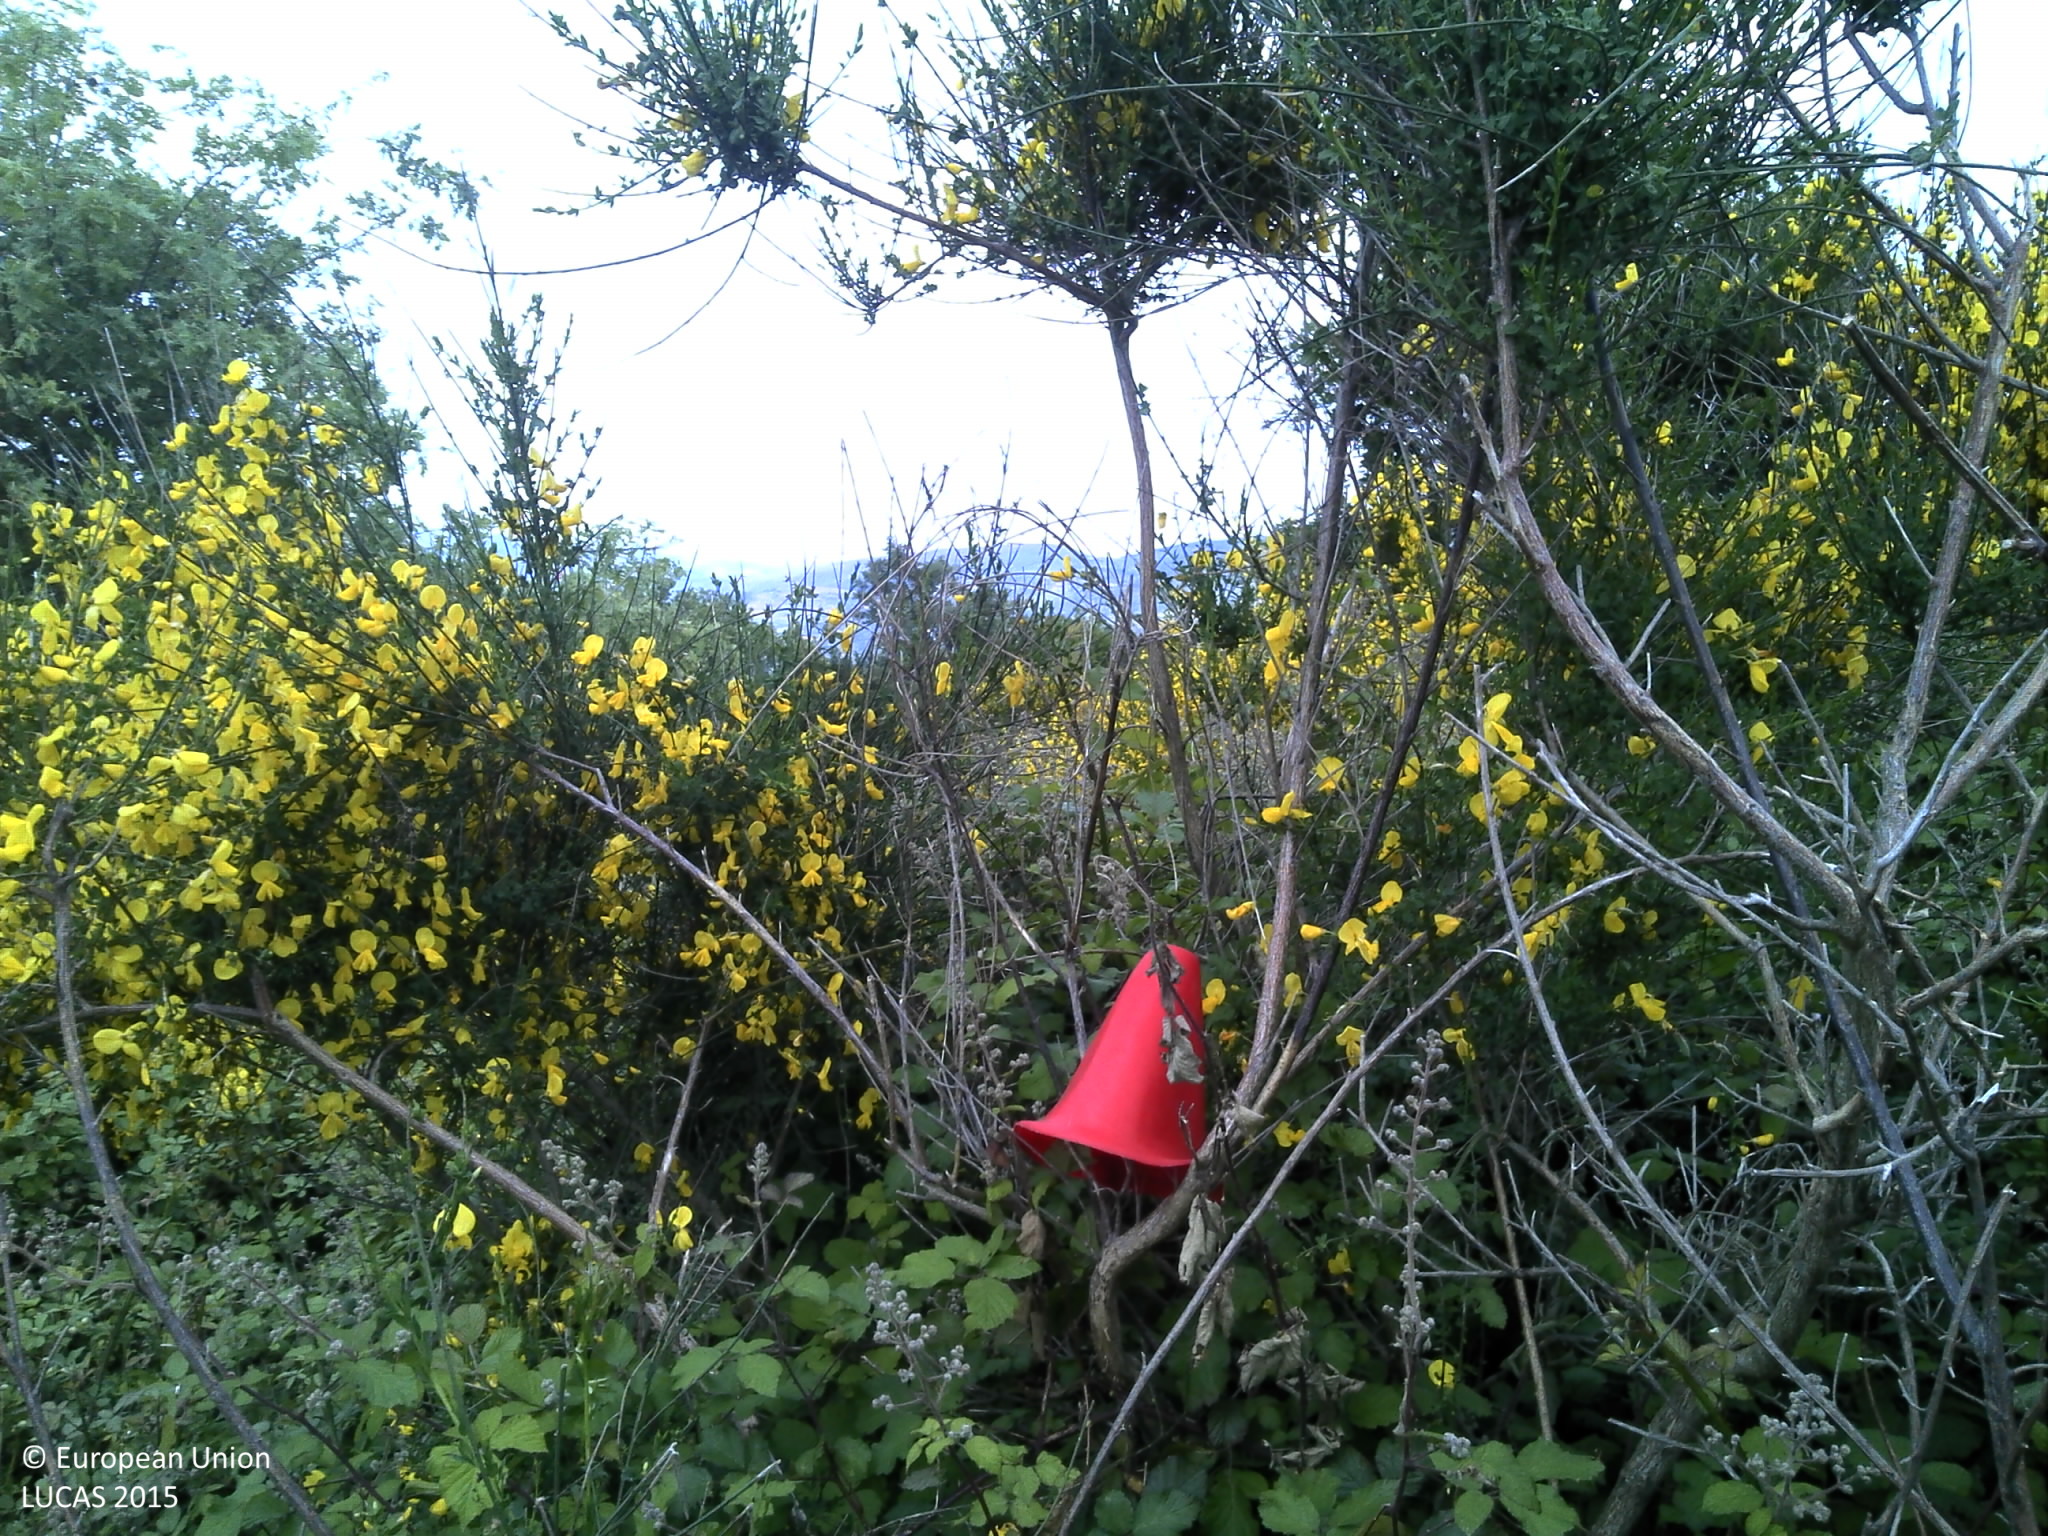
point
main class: Shrubland
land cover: Shrubland without tree cover
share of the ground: > 75 %
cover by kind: shrubs 90 %, herbaceous plants 5 %, unconsolidated bare surface 5 %
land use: Abandoned areas
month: May
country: PT
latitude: 41.0937
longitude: -7.9308
